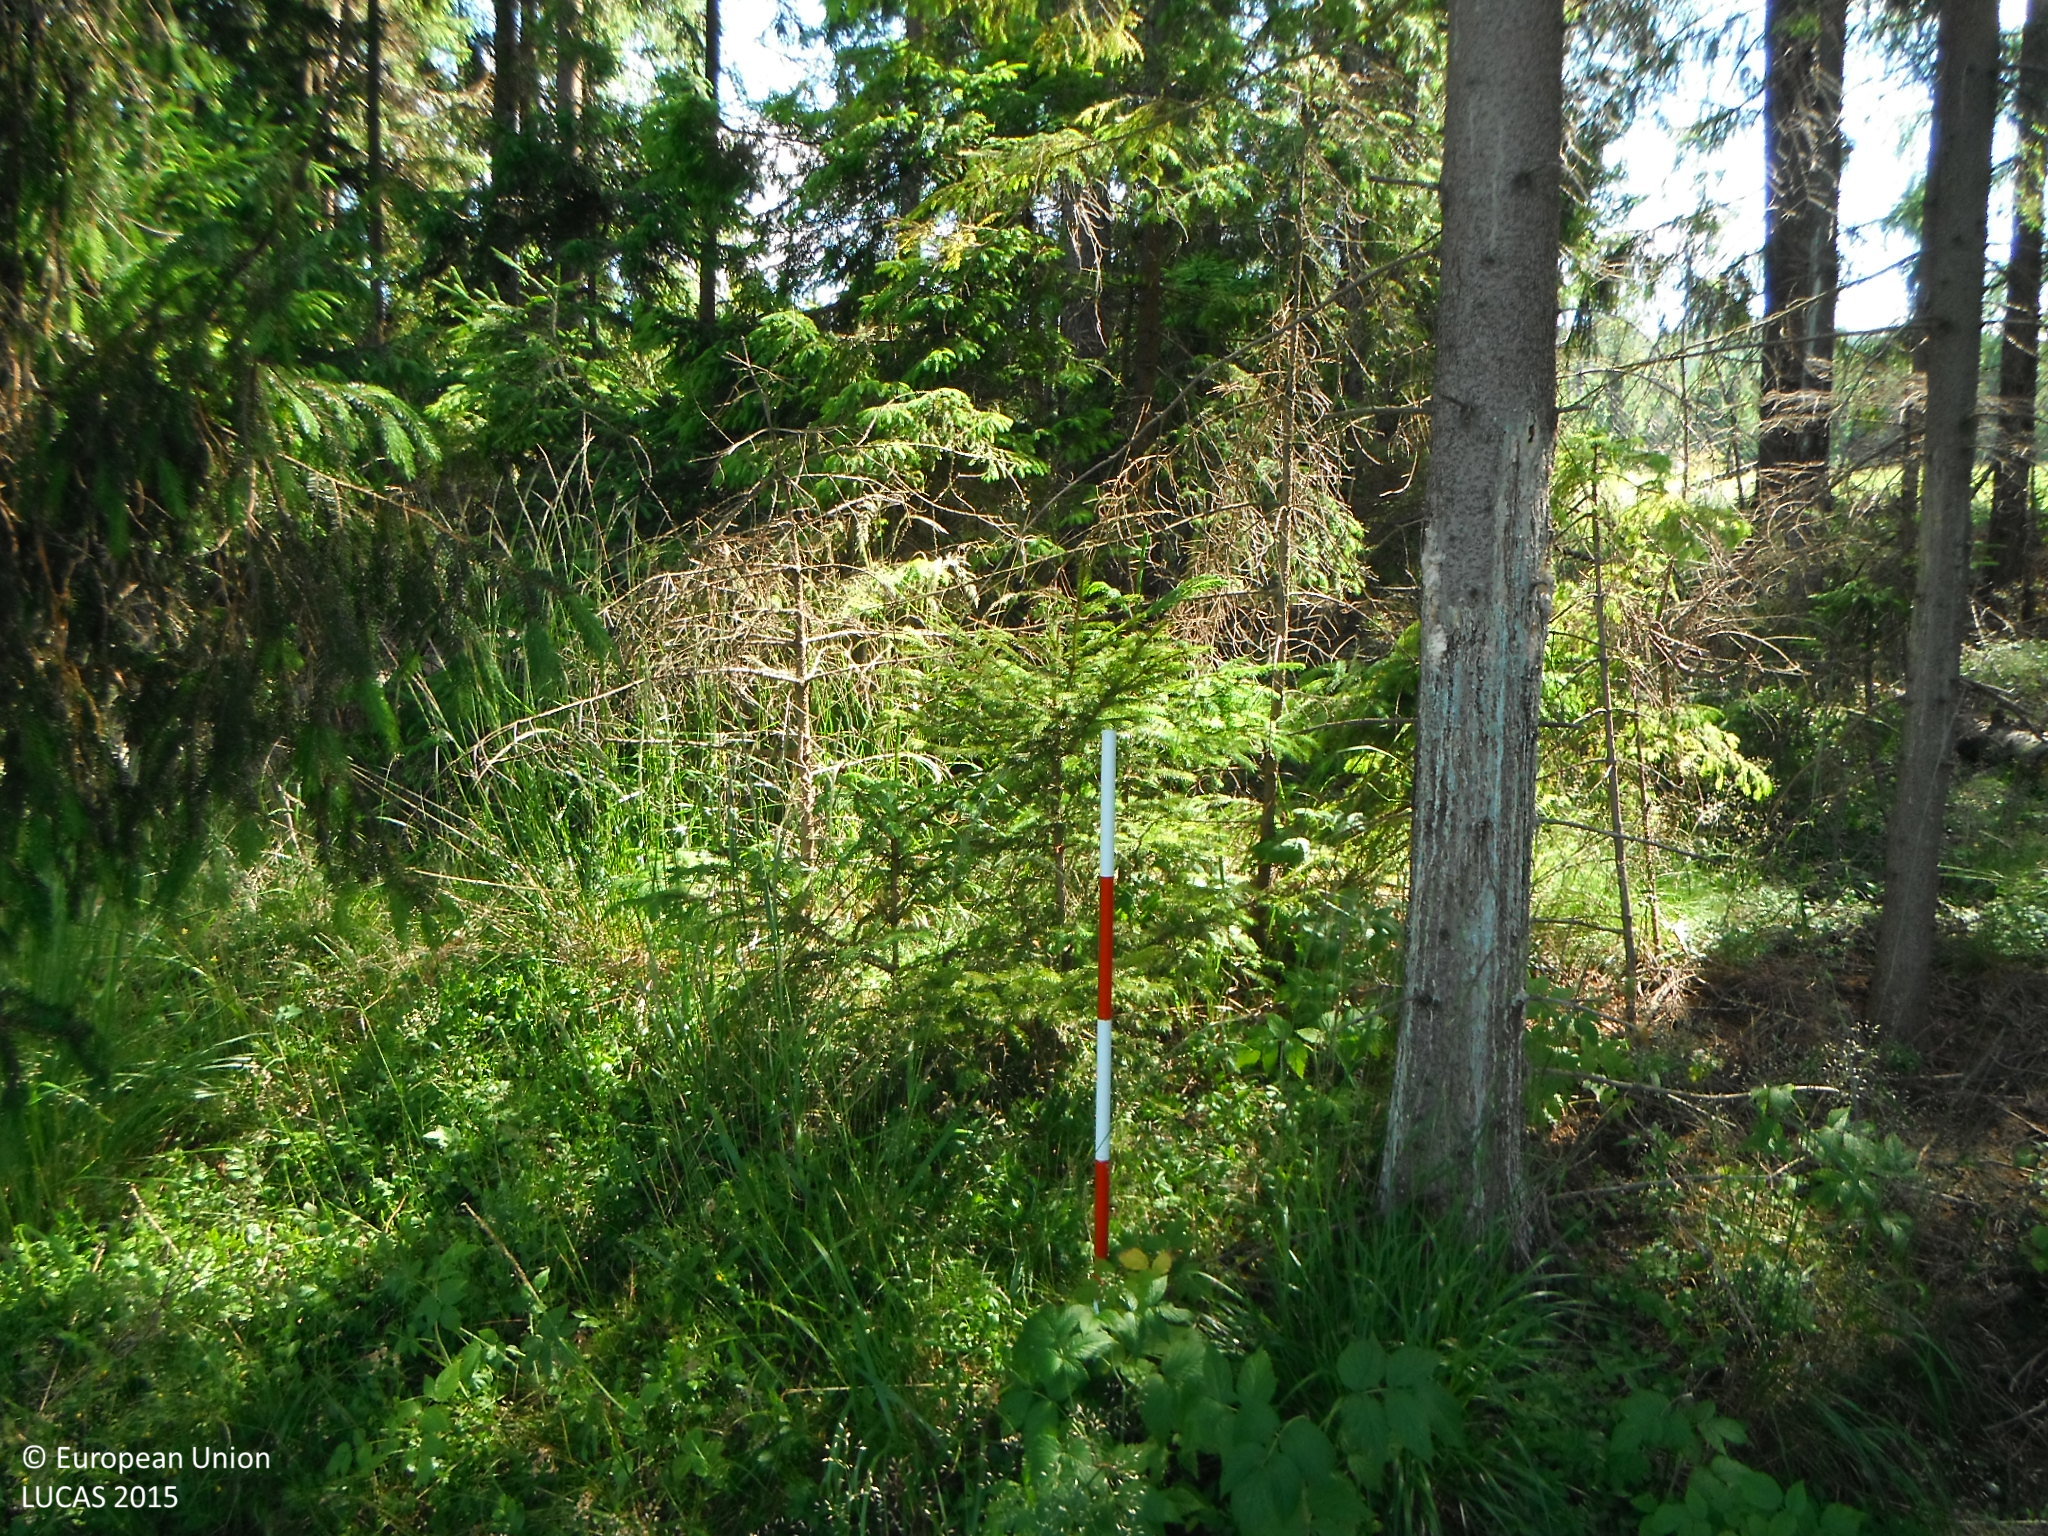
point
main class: Woodland
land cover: Spruce dominated coniferous woodland
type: alpine coniferous forest
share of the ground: > 75 %
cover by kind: coniferous forest trees 85 %, herbaceous plants 15 %
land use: Forestry
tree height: > 5 m
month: July
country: SK
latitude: 48.9762
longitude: 20.2665
